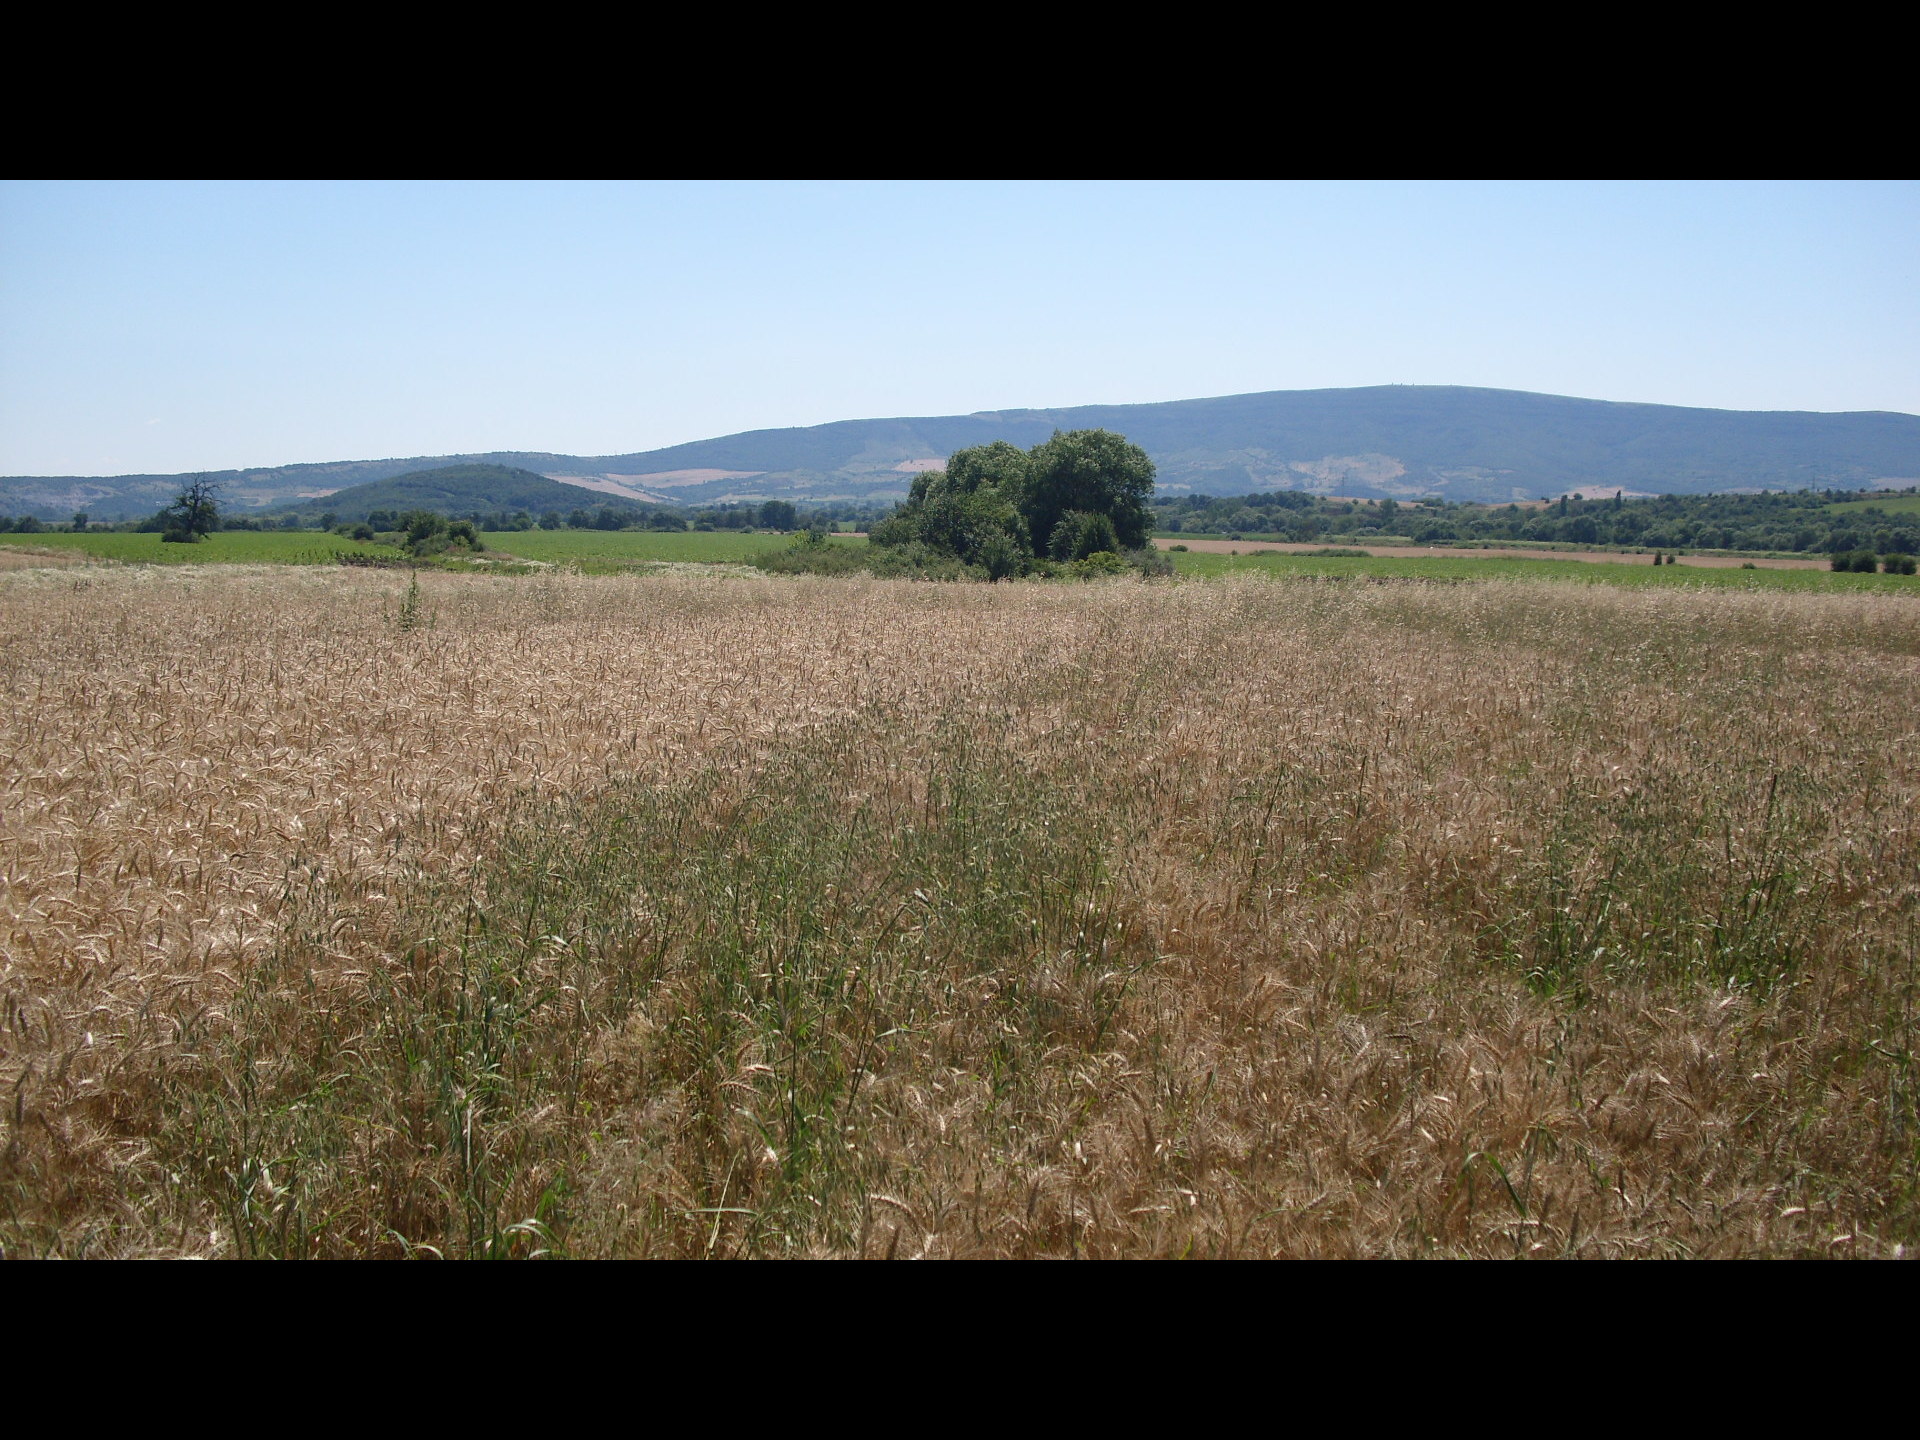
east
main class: Cropland
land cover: Common wheat
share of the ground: > 75 %
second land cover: Oats
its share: 10 - 25 %
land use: Agriculture (excluding fallow land and kitchen gardens)
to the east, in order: Common wheat; Oats; Tracks; Grass margins; Sunflower
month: June
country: BG
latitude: 43.4629
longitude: 23.2282
